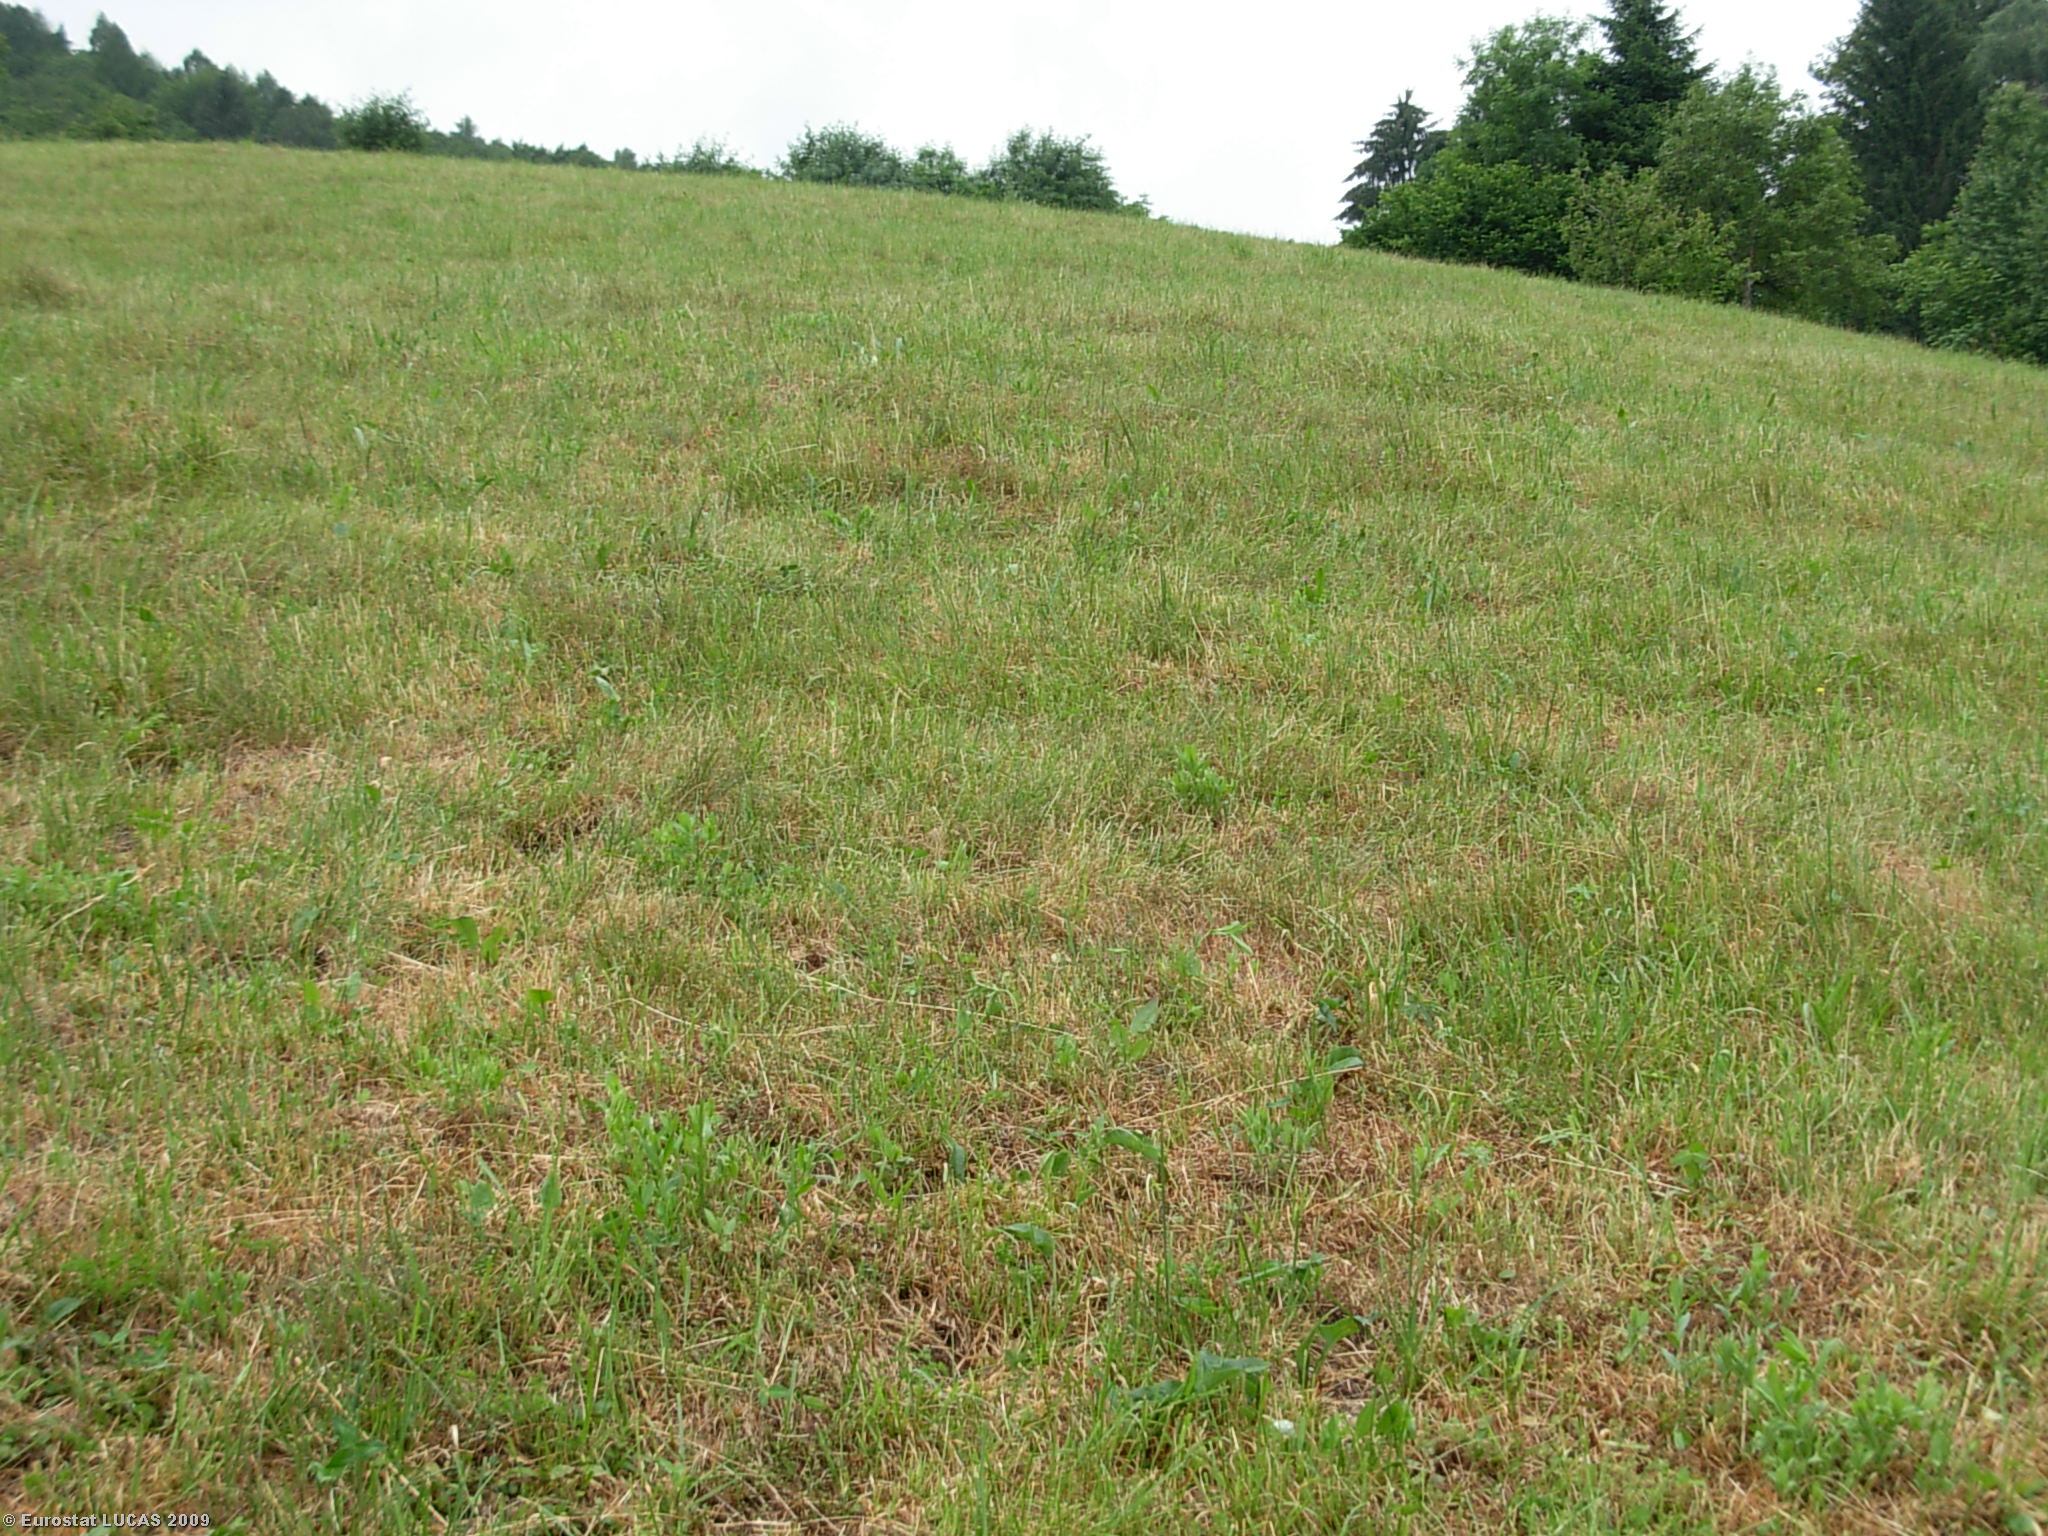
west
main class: Grassland
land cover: Grassland without tree/shrub cover
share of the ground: > 75 %
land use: Agriculture (excluding fallow land and kitchen gardens)
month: June
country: IT
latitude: 45.8278
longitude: 10.4498
